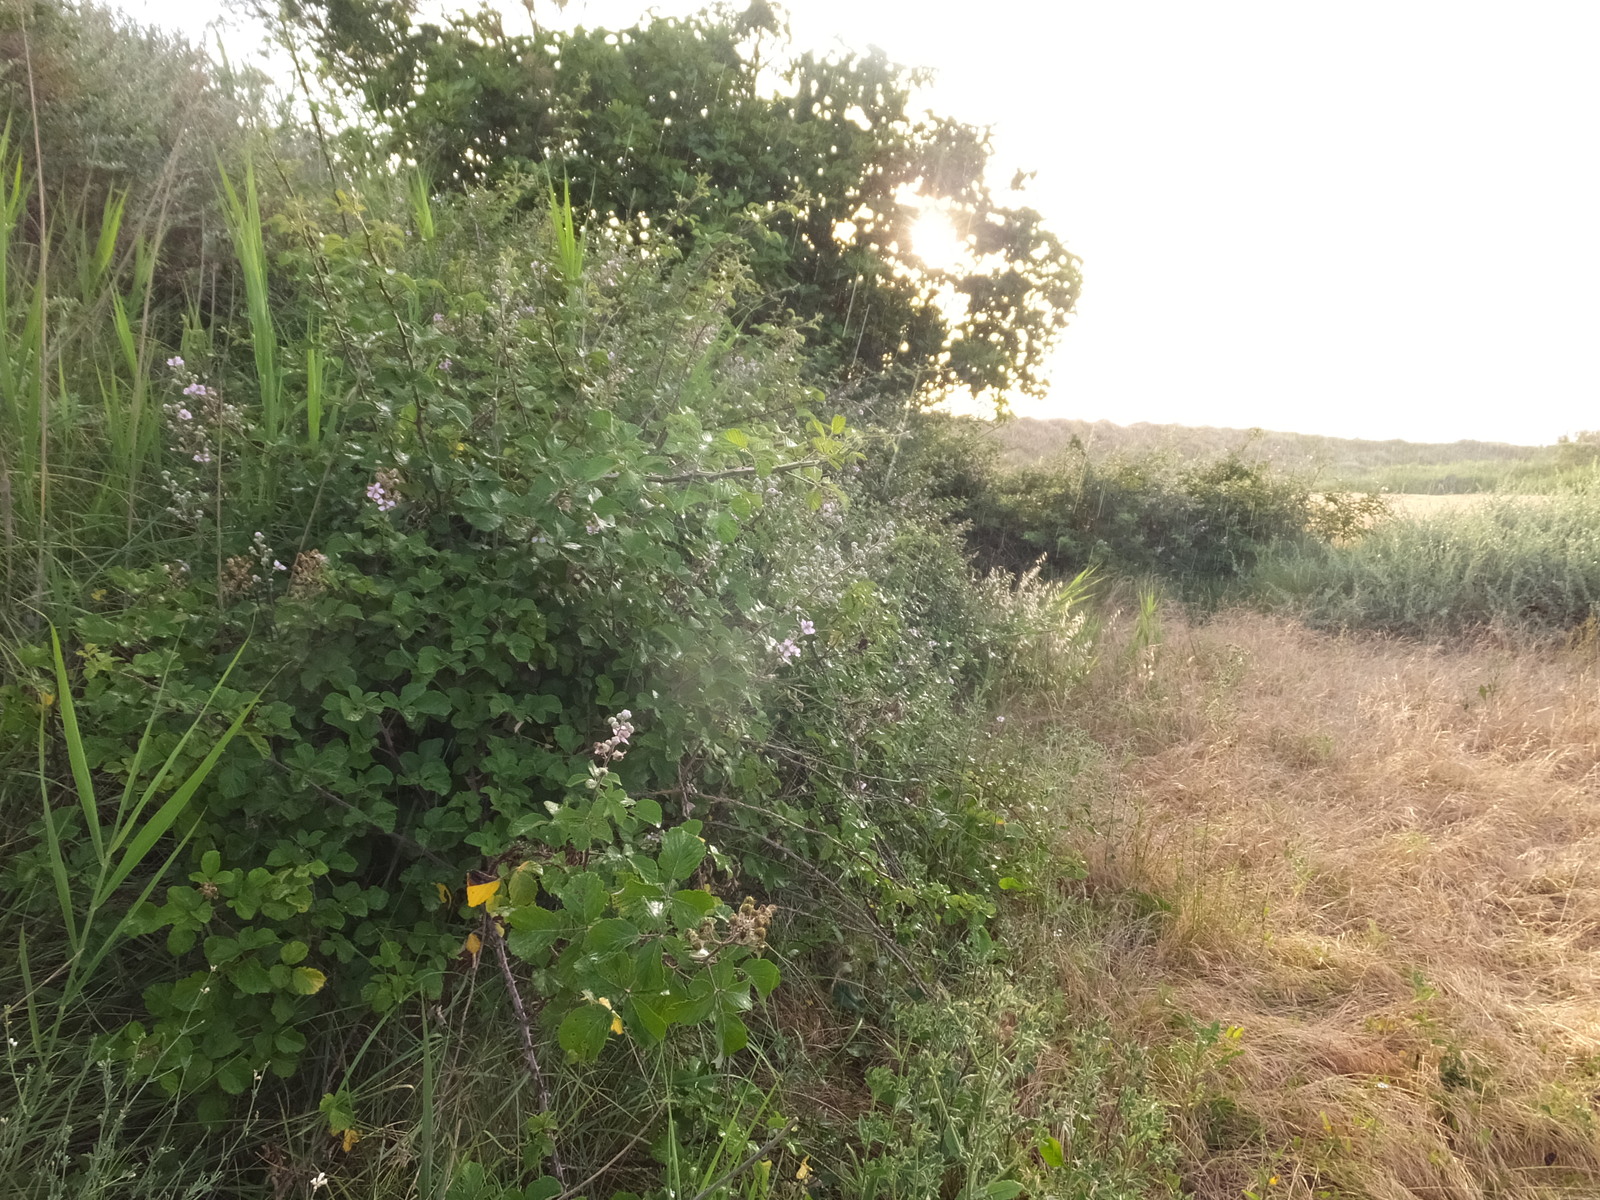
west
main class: Grassland
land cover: Grassland with sparse tree/shrub cover
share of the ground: > 75 %
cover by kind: herbaceous plants 85 %, shrubs 10 %, broadleaved forest trees 5 %
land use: Semi-natural and natural areas not in use
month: June
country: ES
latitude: 41.6899
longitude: 0.0480
